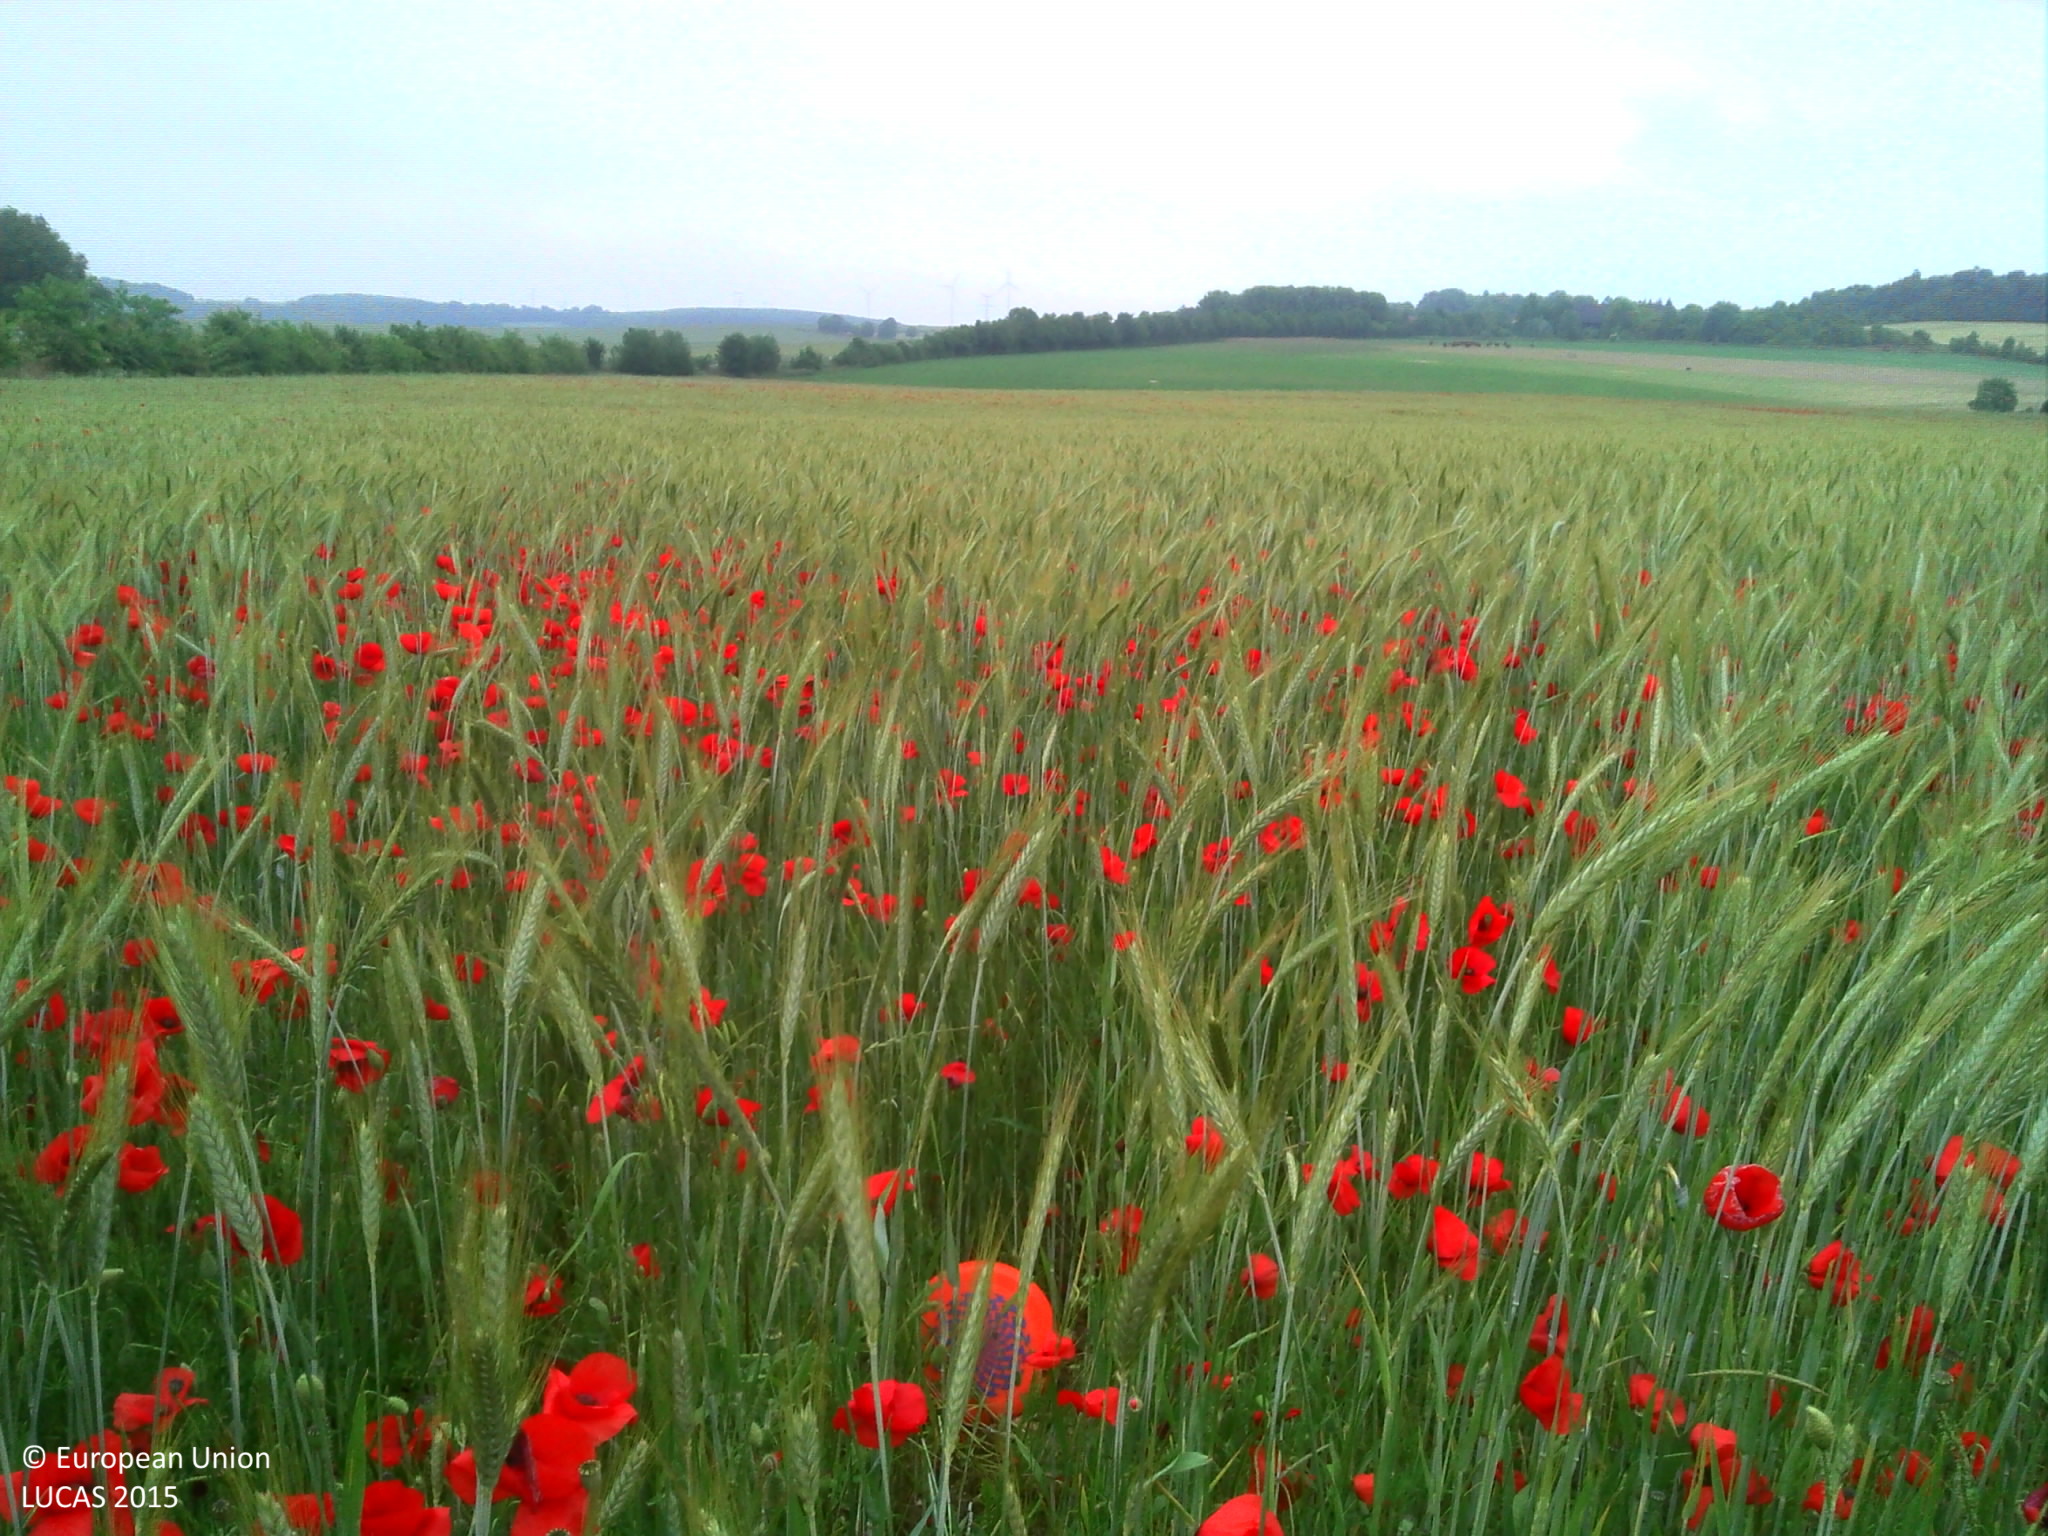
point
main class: Cropland
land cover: Barley
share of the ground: > 75 %
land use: Agriculture (excluding fallow land and kitchen gardens)
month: June
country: FR
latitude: 49.7363
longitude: 2.2021
